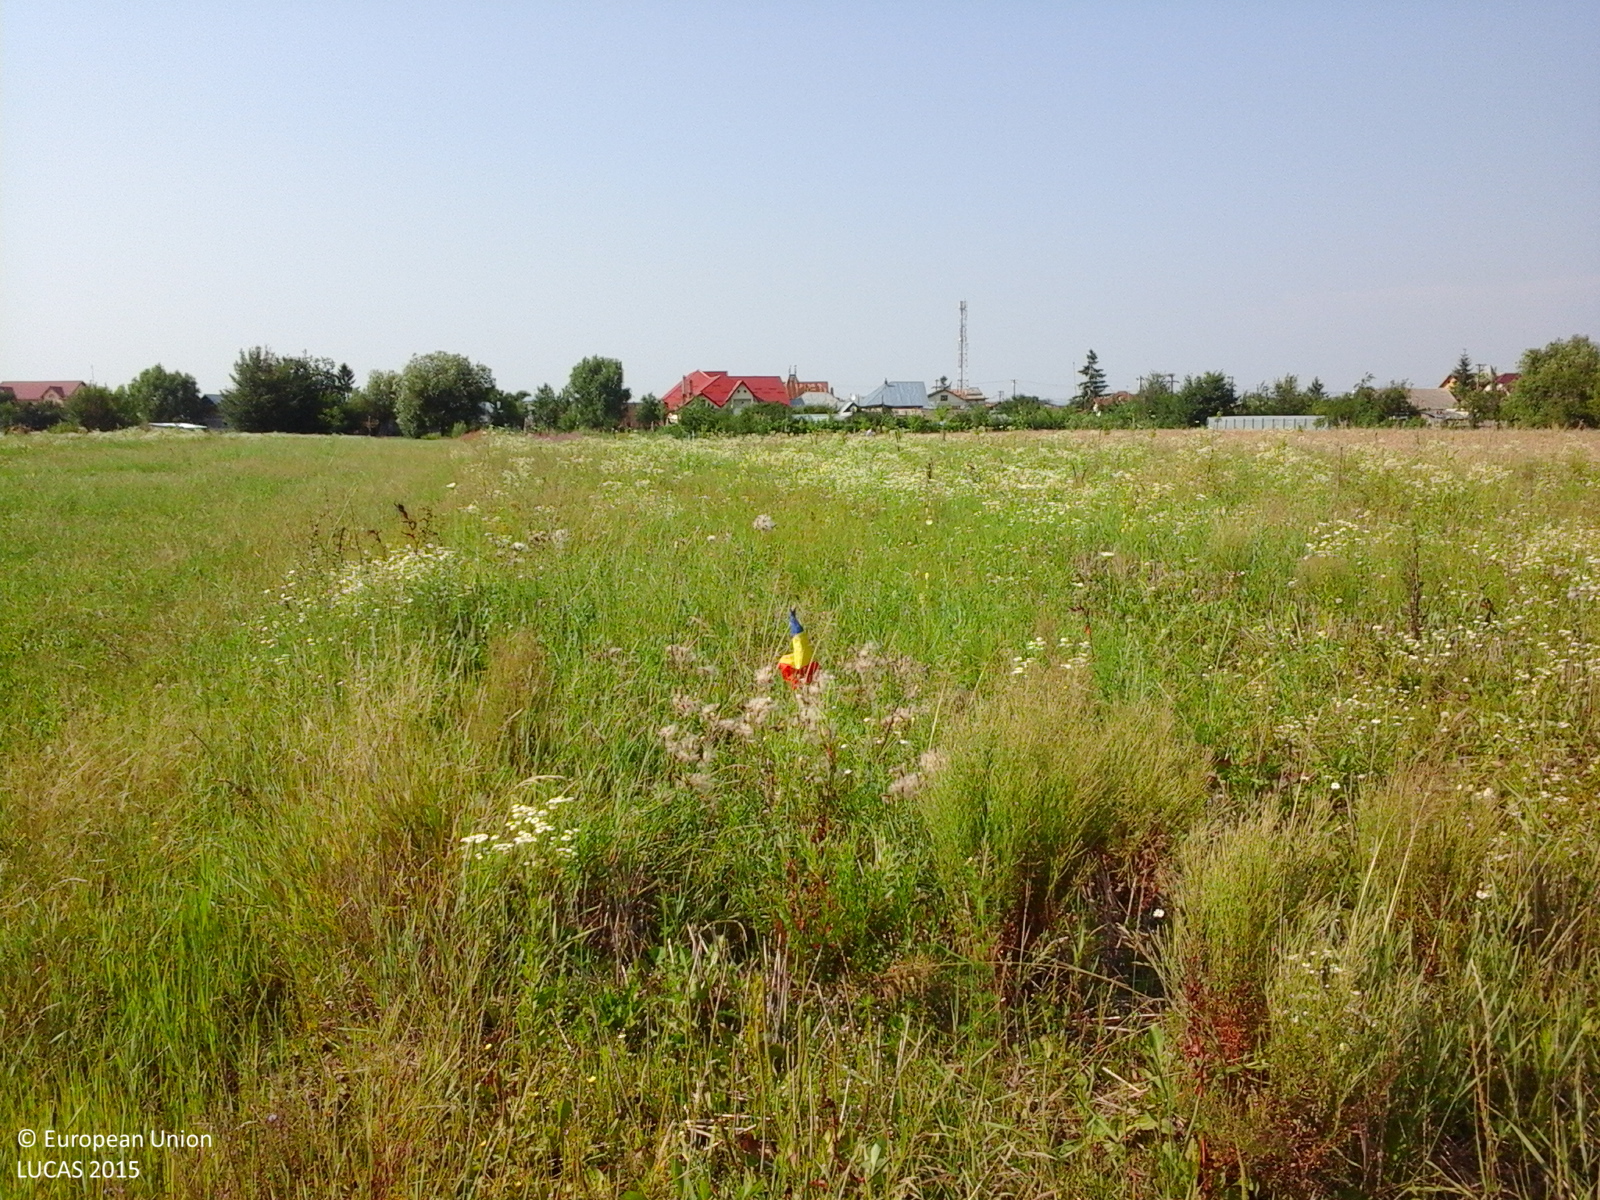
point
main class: Grassland
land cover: Spontaneously vegetated surfaces
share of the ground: > 75 %
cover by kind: herbaceous plants 100 %
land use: Fallow land
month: July
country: RO
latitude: 44.8674
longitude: 25.6020
